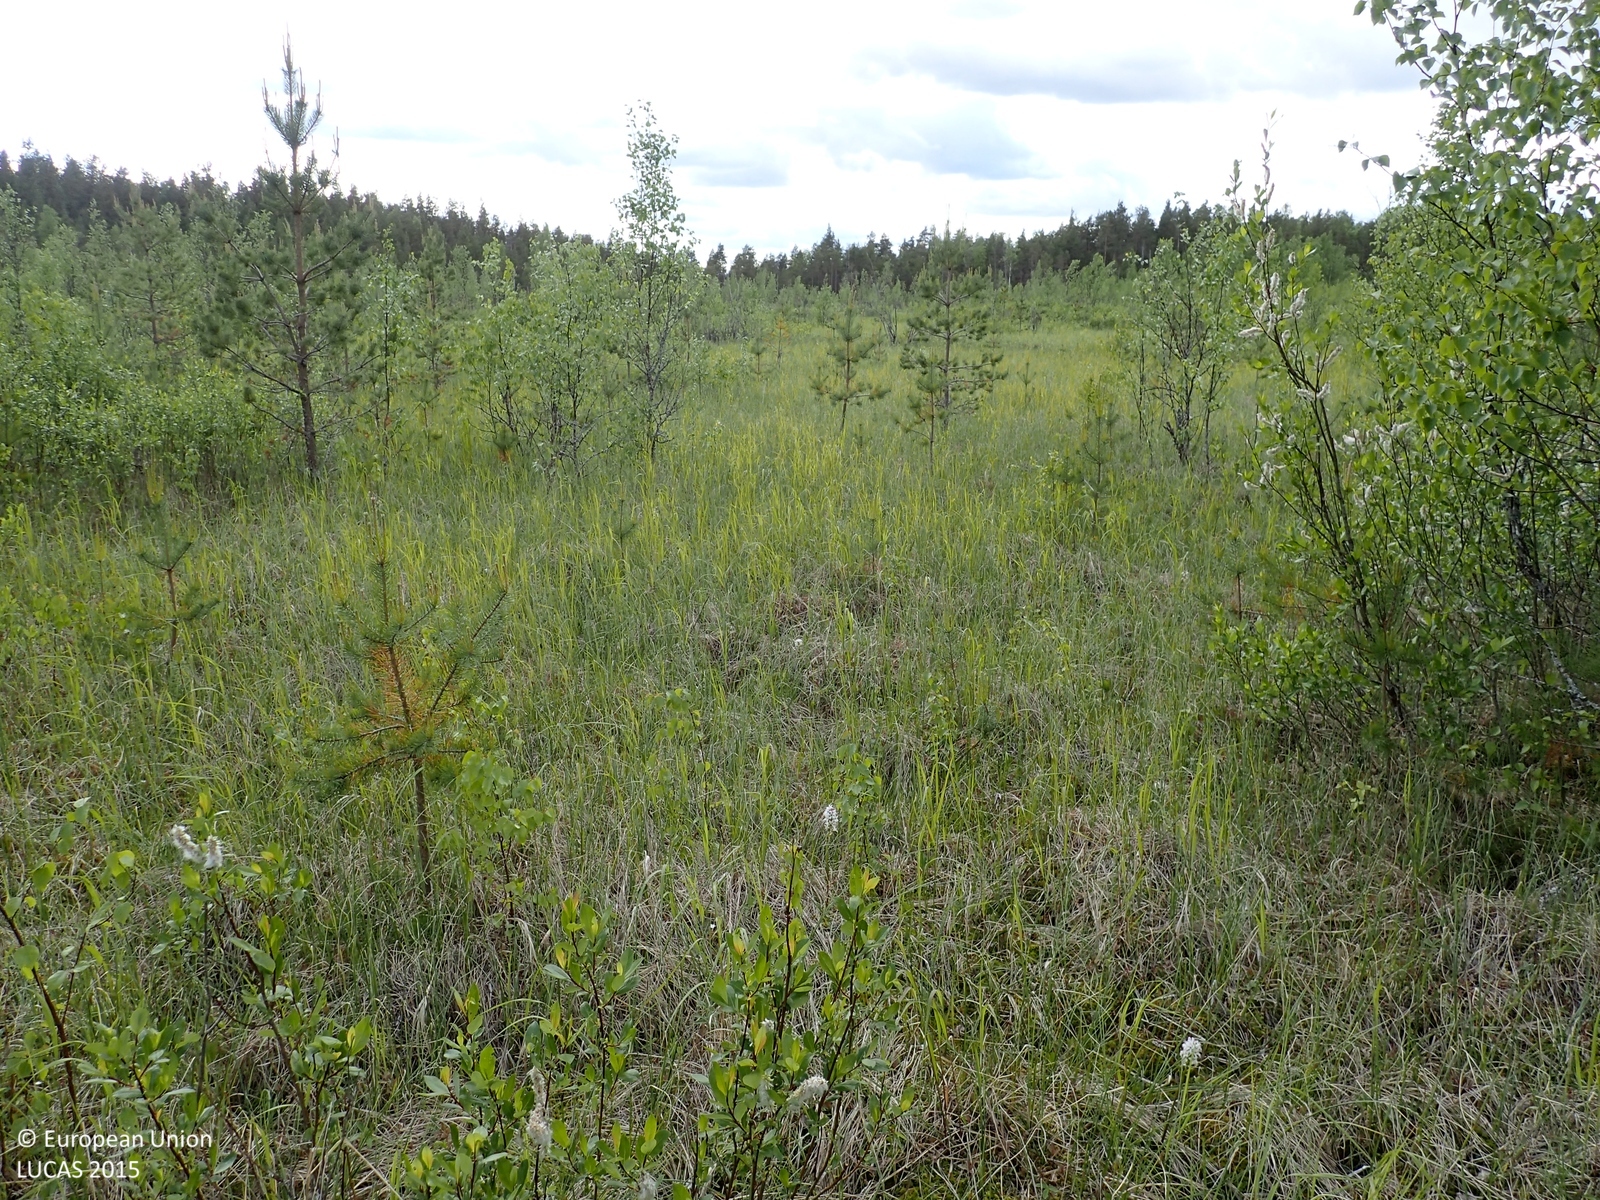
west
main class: Woodland
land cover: Pine dominated mixed woodland
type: mire and swamp forests
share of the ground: 10 - 25 %
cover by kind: herbaceous plants 70 %, broadleaved forest trees 10 %, shrubs 10 %, coniferous forest trees 5 %, lichens and mosses 5 %
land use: Forestry
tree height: < 5 m
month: June
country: FI
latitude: 62.5986
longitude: 23.1728
